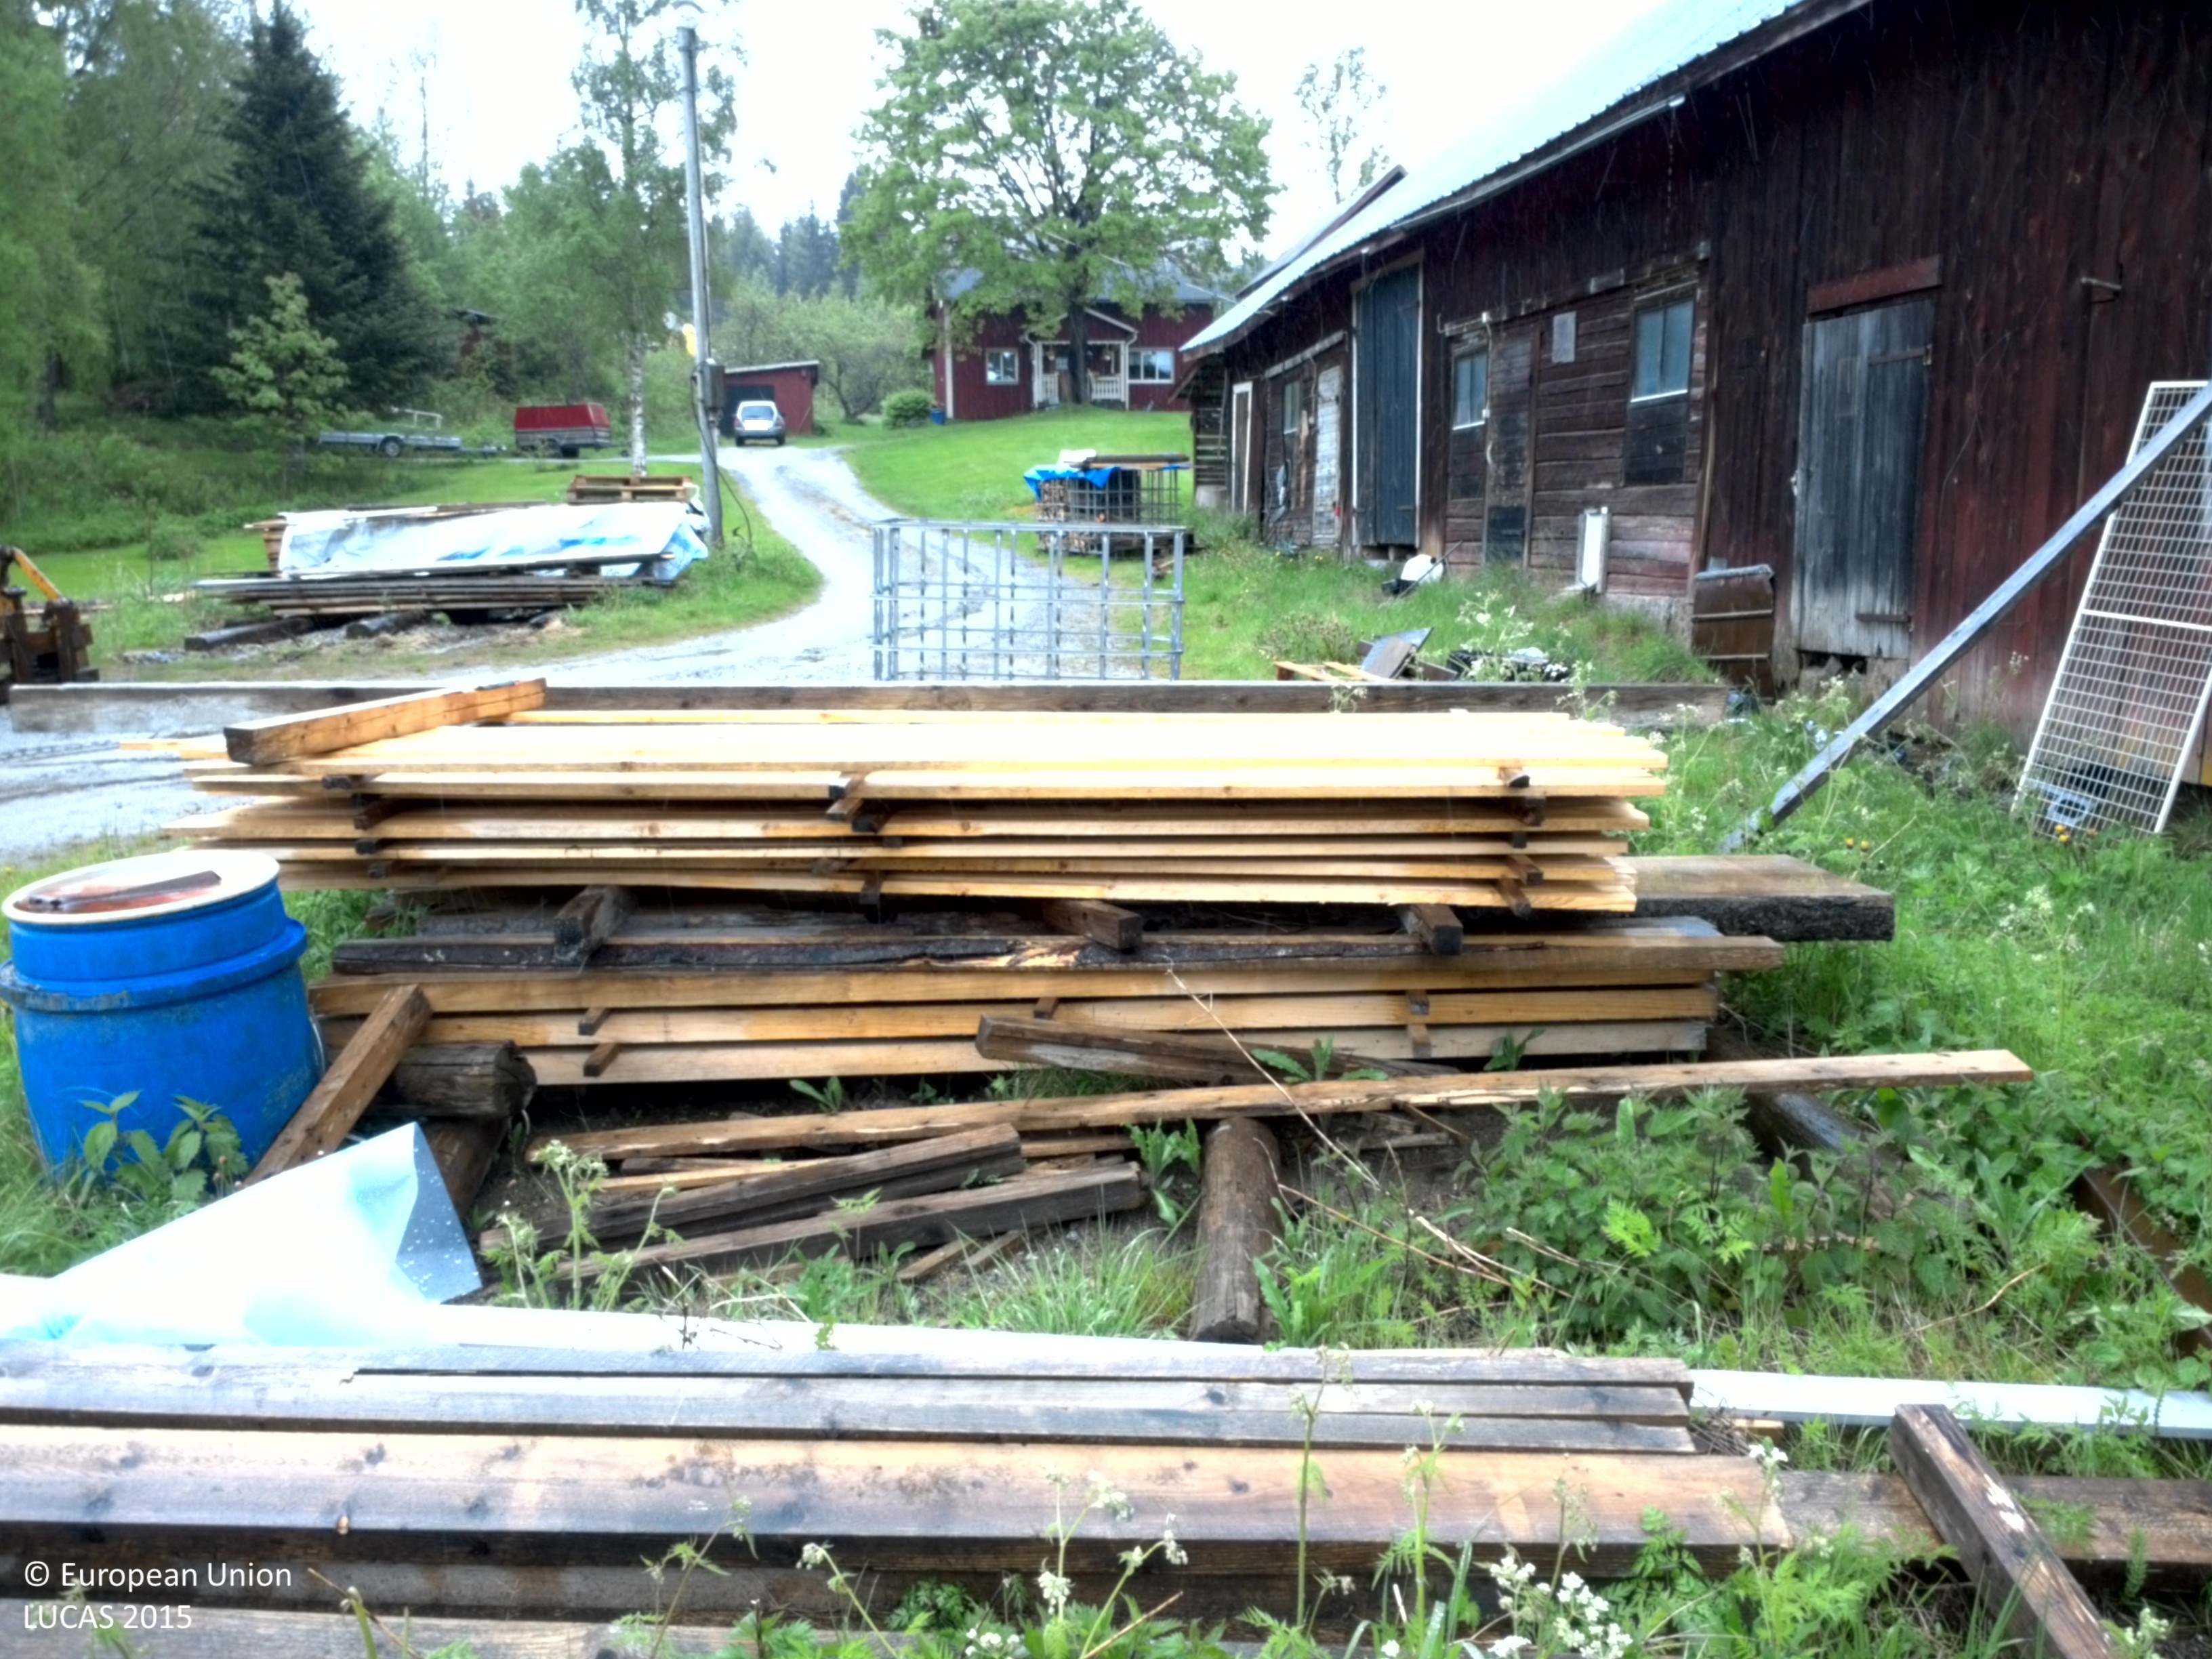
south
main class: Grassland
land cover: Spontaneously vegetated surfaces
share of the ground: > 75 %
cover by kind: herbaceous plants 90 %, shrubs 5 %
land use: Residential
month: June
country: SE
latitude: 59.6915
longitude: 12.4273
